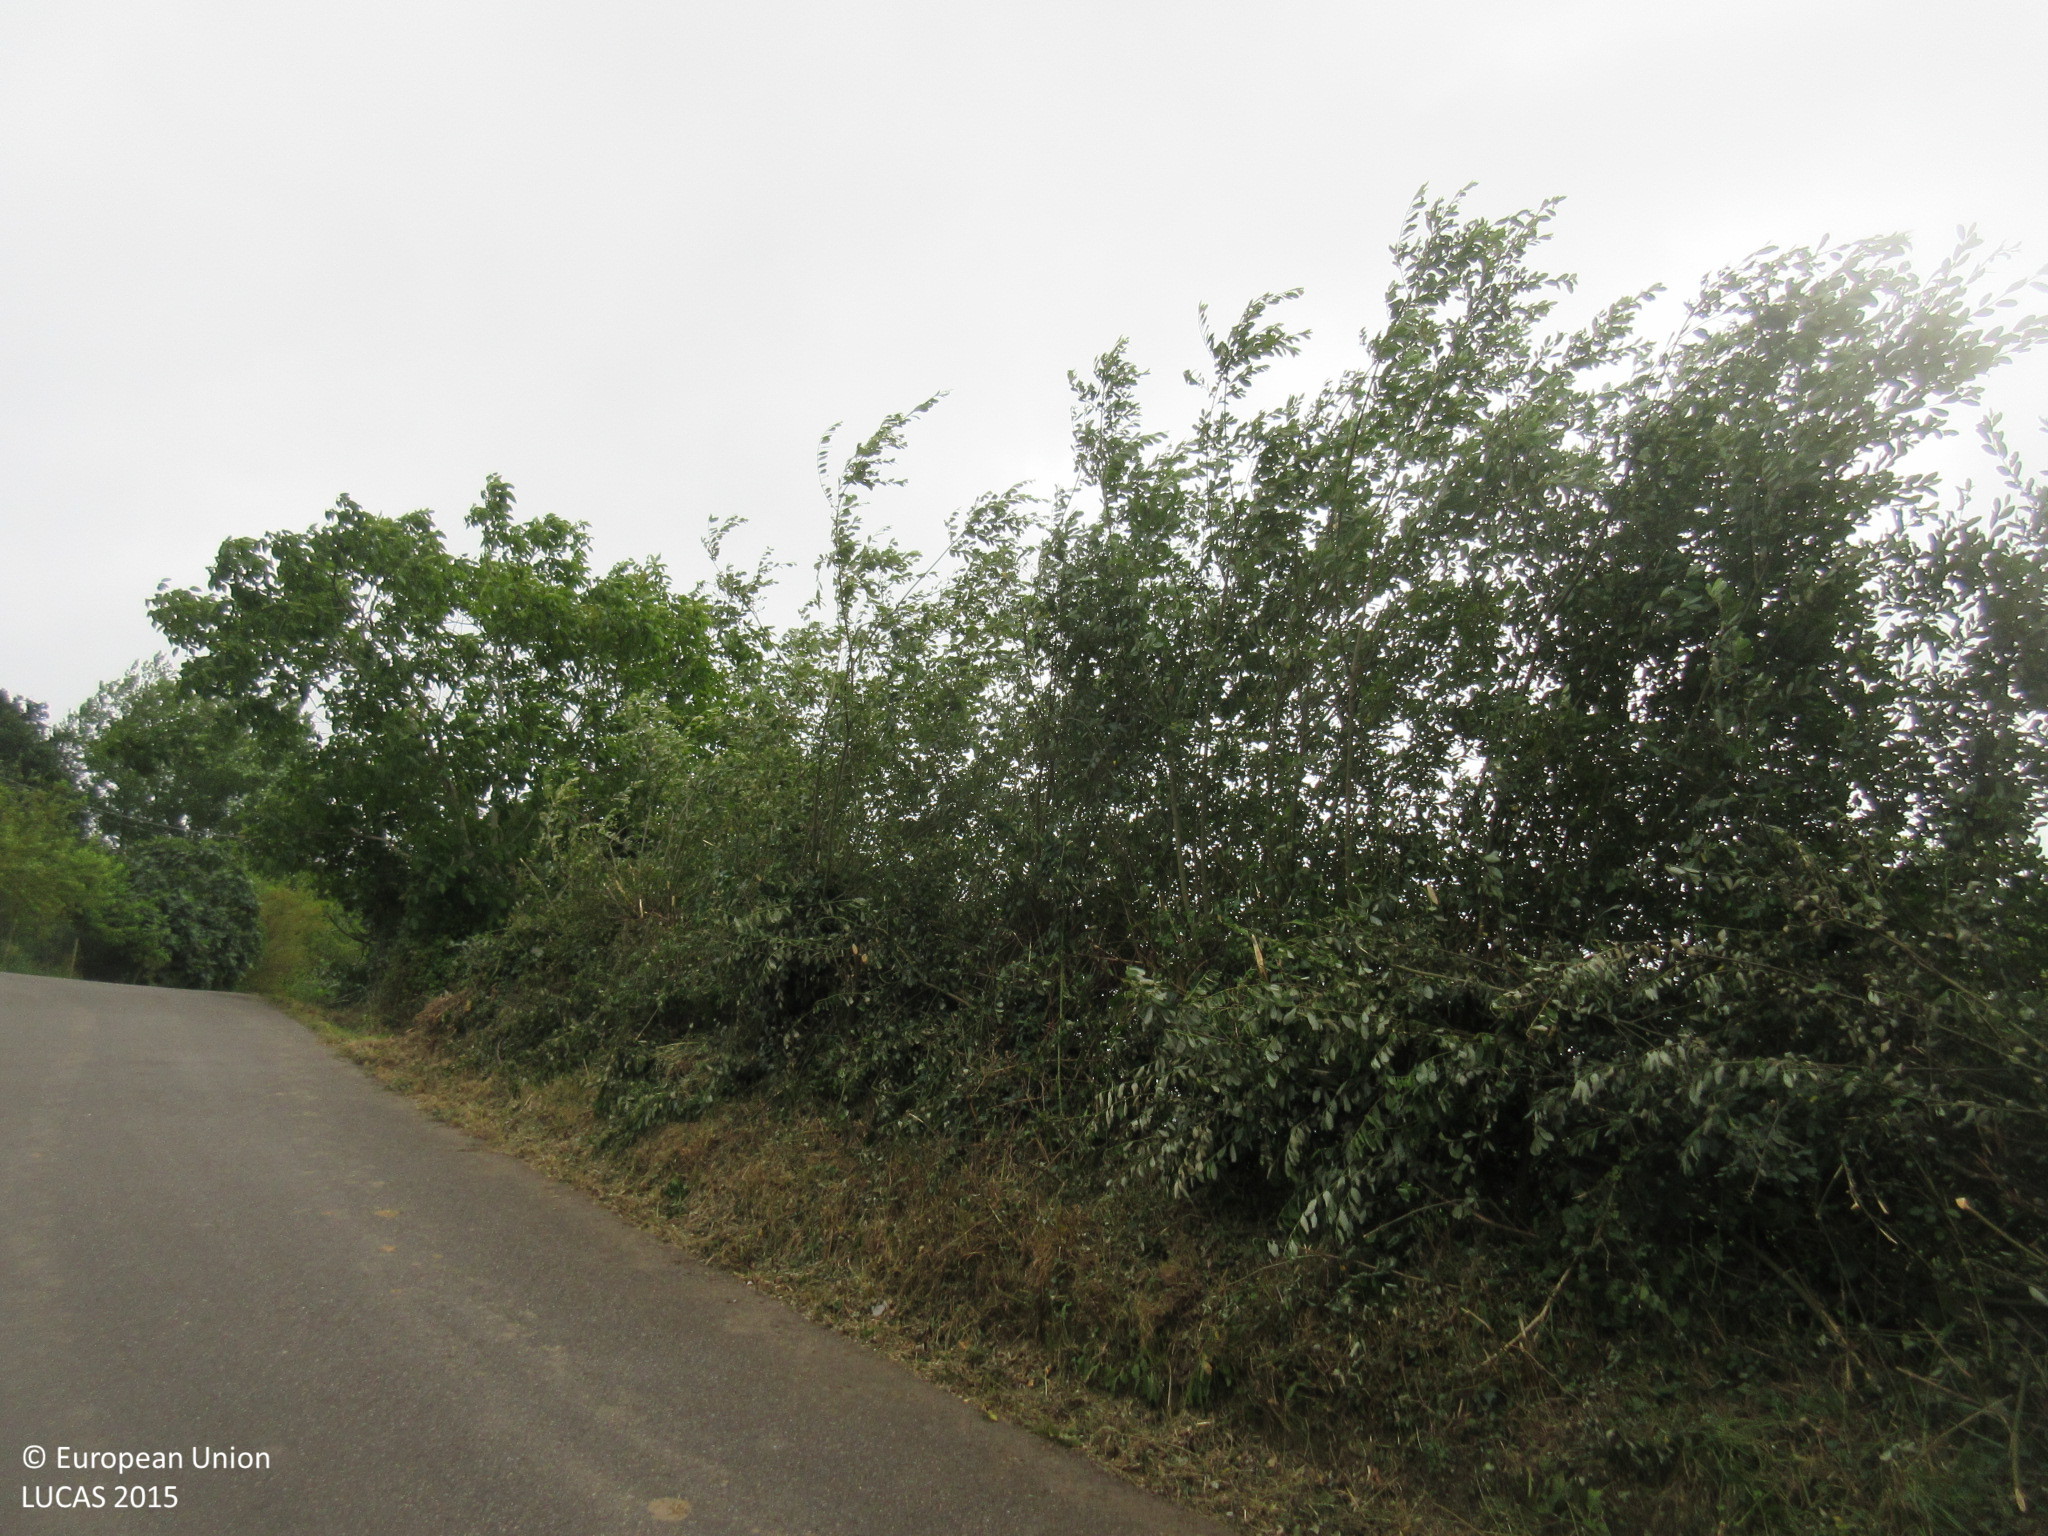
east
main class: Cropland
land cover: Pear fruit
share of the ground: > 75 %
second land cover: Grassland without tree/shrub cover
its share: > 75 %
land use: Kitchen garden
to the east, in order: Pear fruit; Grassland without tree/shrub cover; Dry stone walls; Tracks; Abandoned hedges; Apple fruit; Maize; Grass margins; Fences; Grassland with sparse tree/shrub cover; Fences; Apple fruit; Fences; Grassland without tree/shrub cover; Tracks; Grass margins; Electric lines; Dry pulses; Potatoes; Fences; Grassland without tree/shrub cover
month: July
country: ES
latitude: 43.3789
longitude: -4.6399
